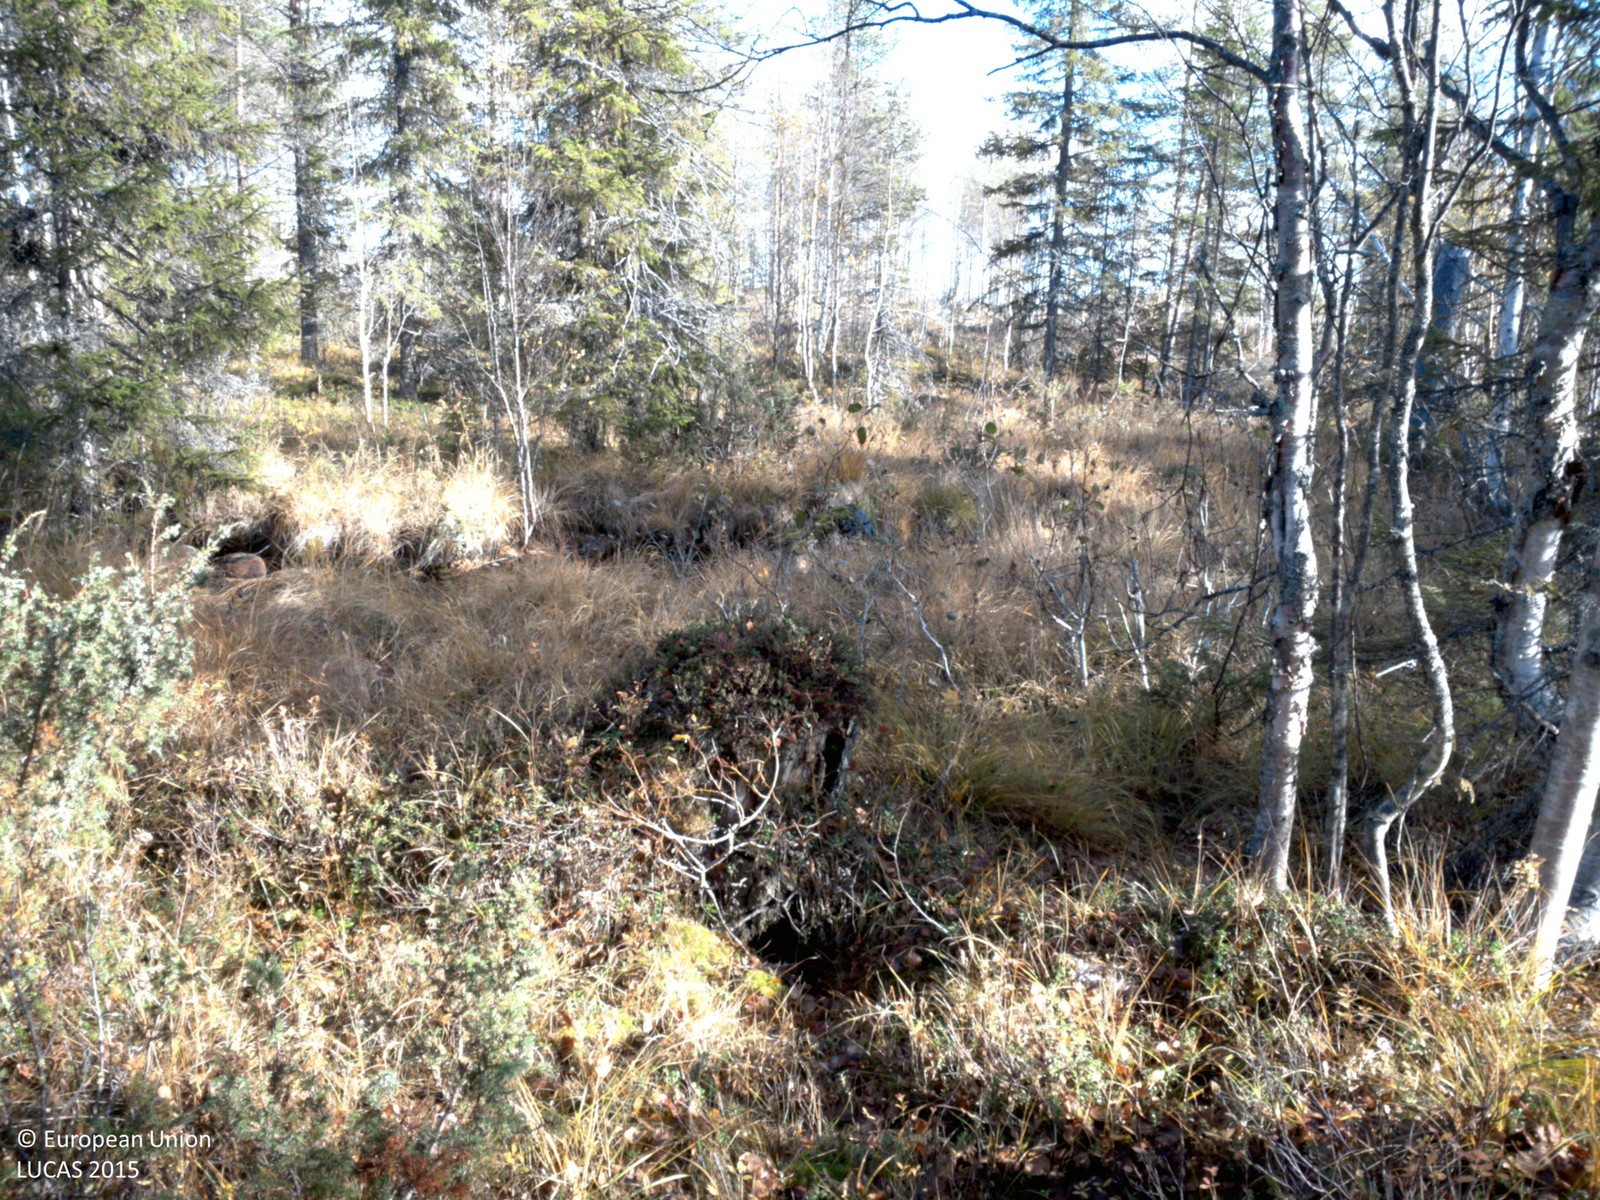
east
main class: Woodland
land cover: Spruce dominated mixed woodland
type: boreal forest
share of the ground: 25 - 50 %
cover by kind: coniferous forest trees 30 %, shrubs 30 %, herbaceous plants 15 %, lichens and mosses 15 %, broadleaved forest trees 10 %
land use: Forestry
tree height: > 5 m
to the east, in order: Spruce dominated mixed woodland; Rivers and streams; Spruce dominated mixed woodland; Pine dominated mixed woodland; Pine dominated coniferous woodland; Shrubland with sparse tree cover
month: October
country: SE
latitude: 64.7848
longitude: 17.8544
